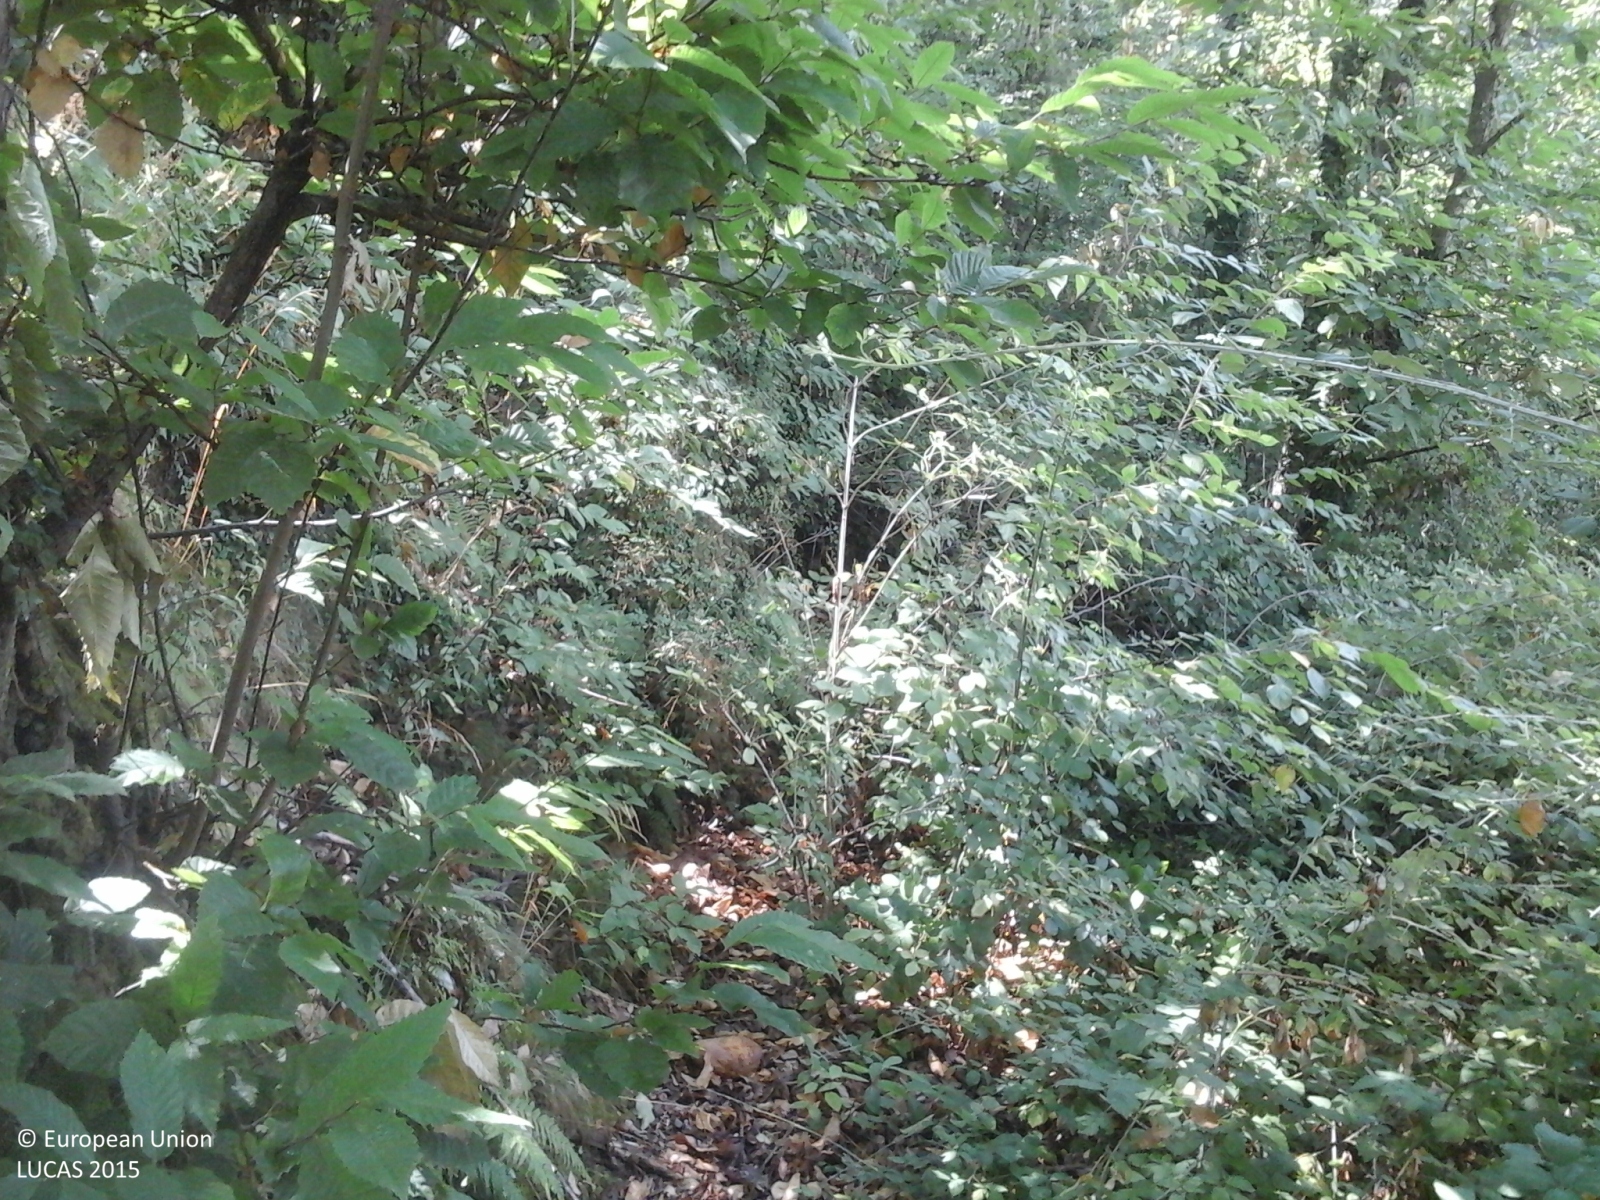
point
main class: Woodland
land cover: Broadleaved woodland
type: thermophilous deciduous forest
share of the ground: > 75 %
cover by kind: broadleaved forest trees 100 %
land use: Forestry
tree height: > 5 m
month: August
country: IT
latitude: 43.8230
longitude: 10.9549
